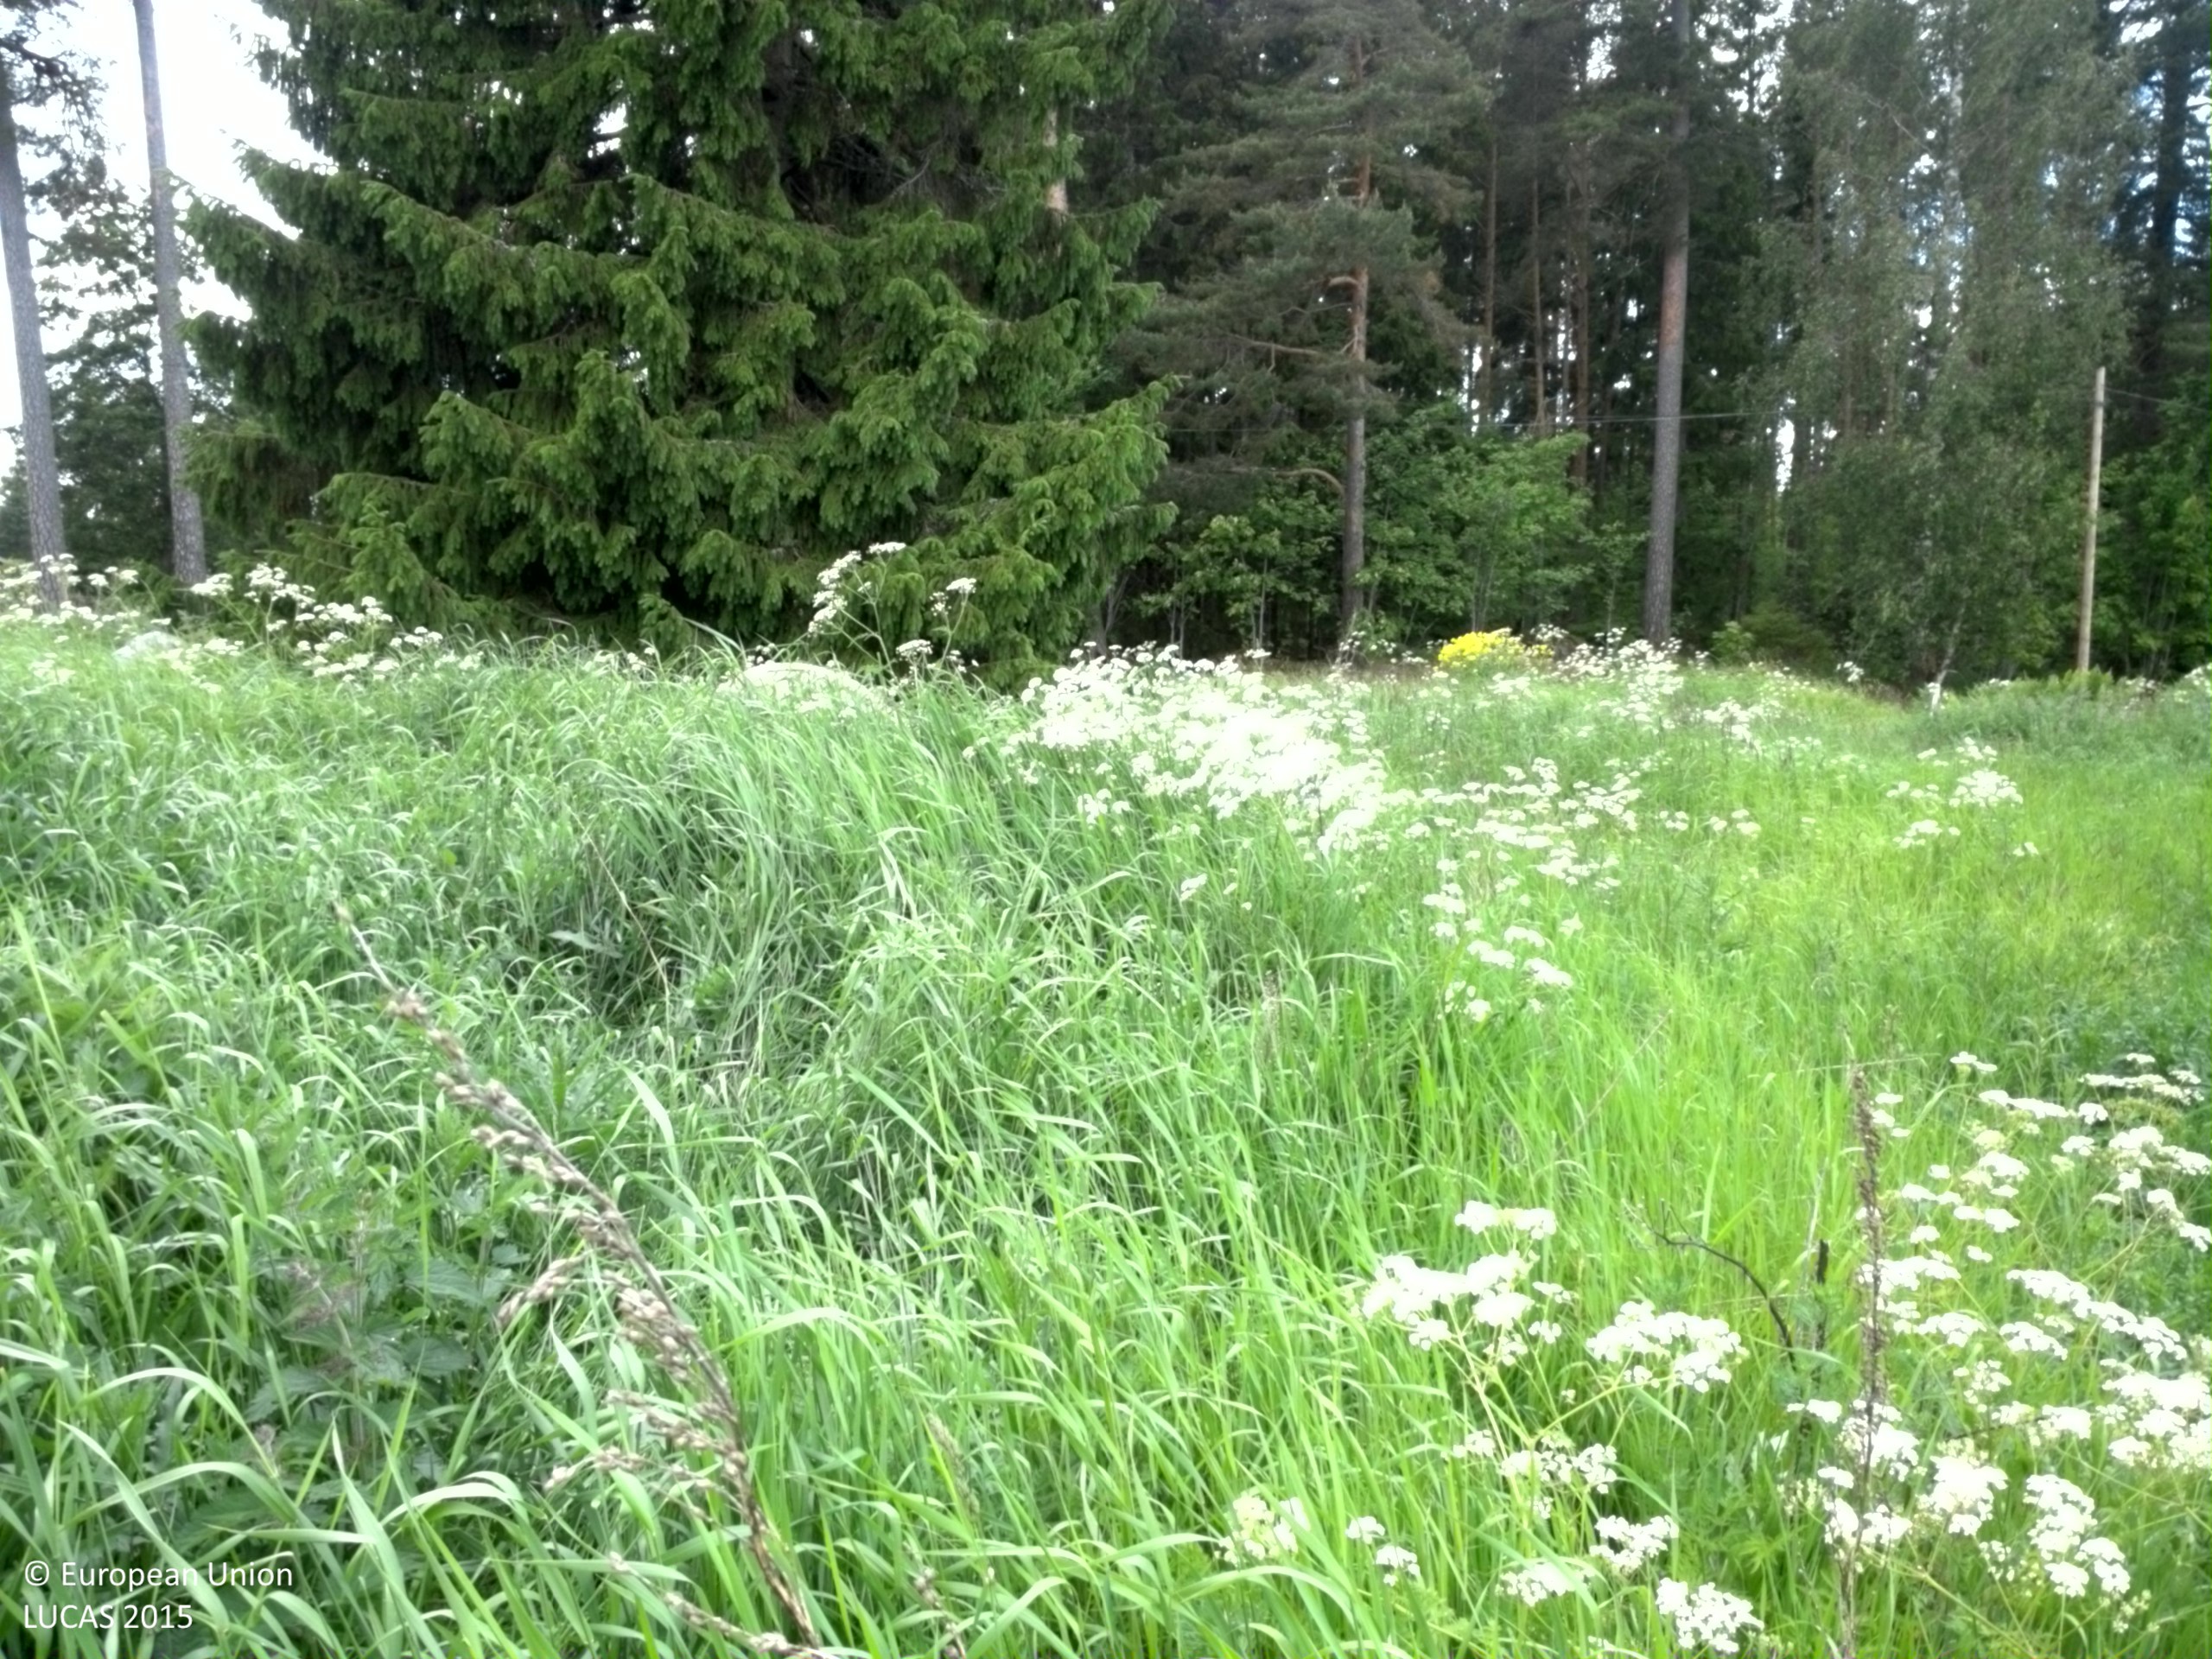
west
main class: Cropland
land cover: Common wheat
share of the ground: > 75 %
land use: Agriculture (excluding fallow land and kitchen gardens)
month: June
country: SE
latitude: 60.4279
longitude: 17.6028
